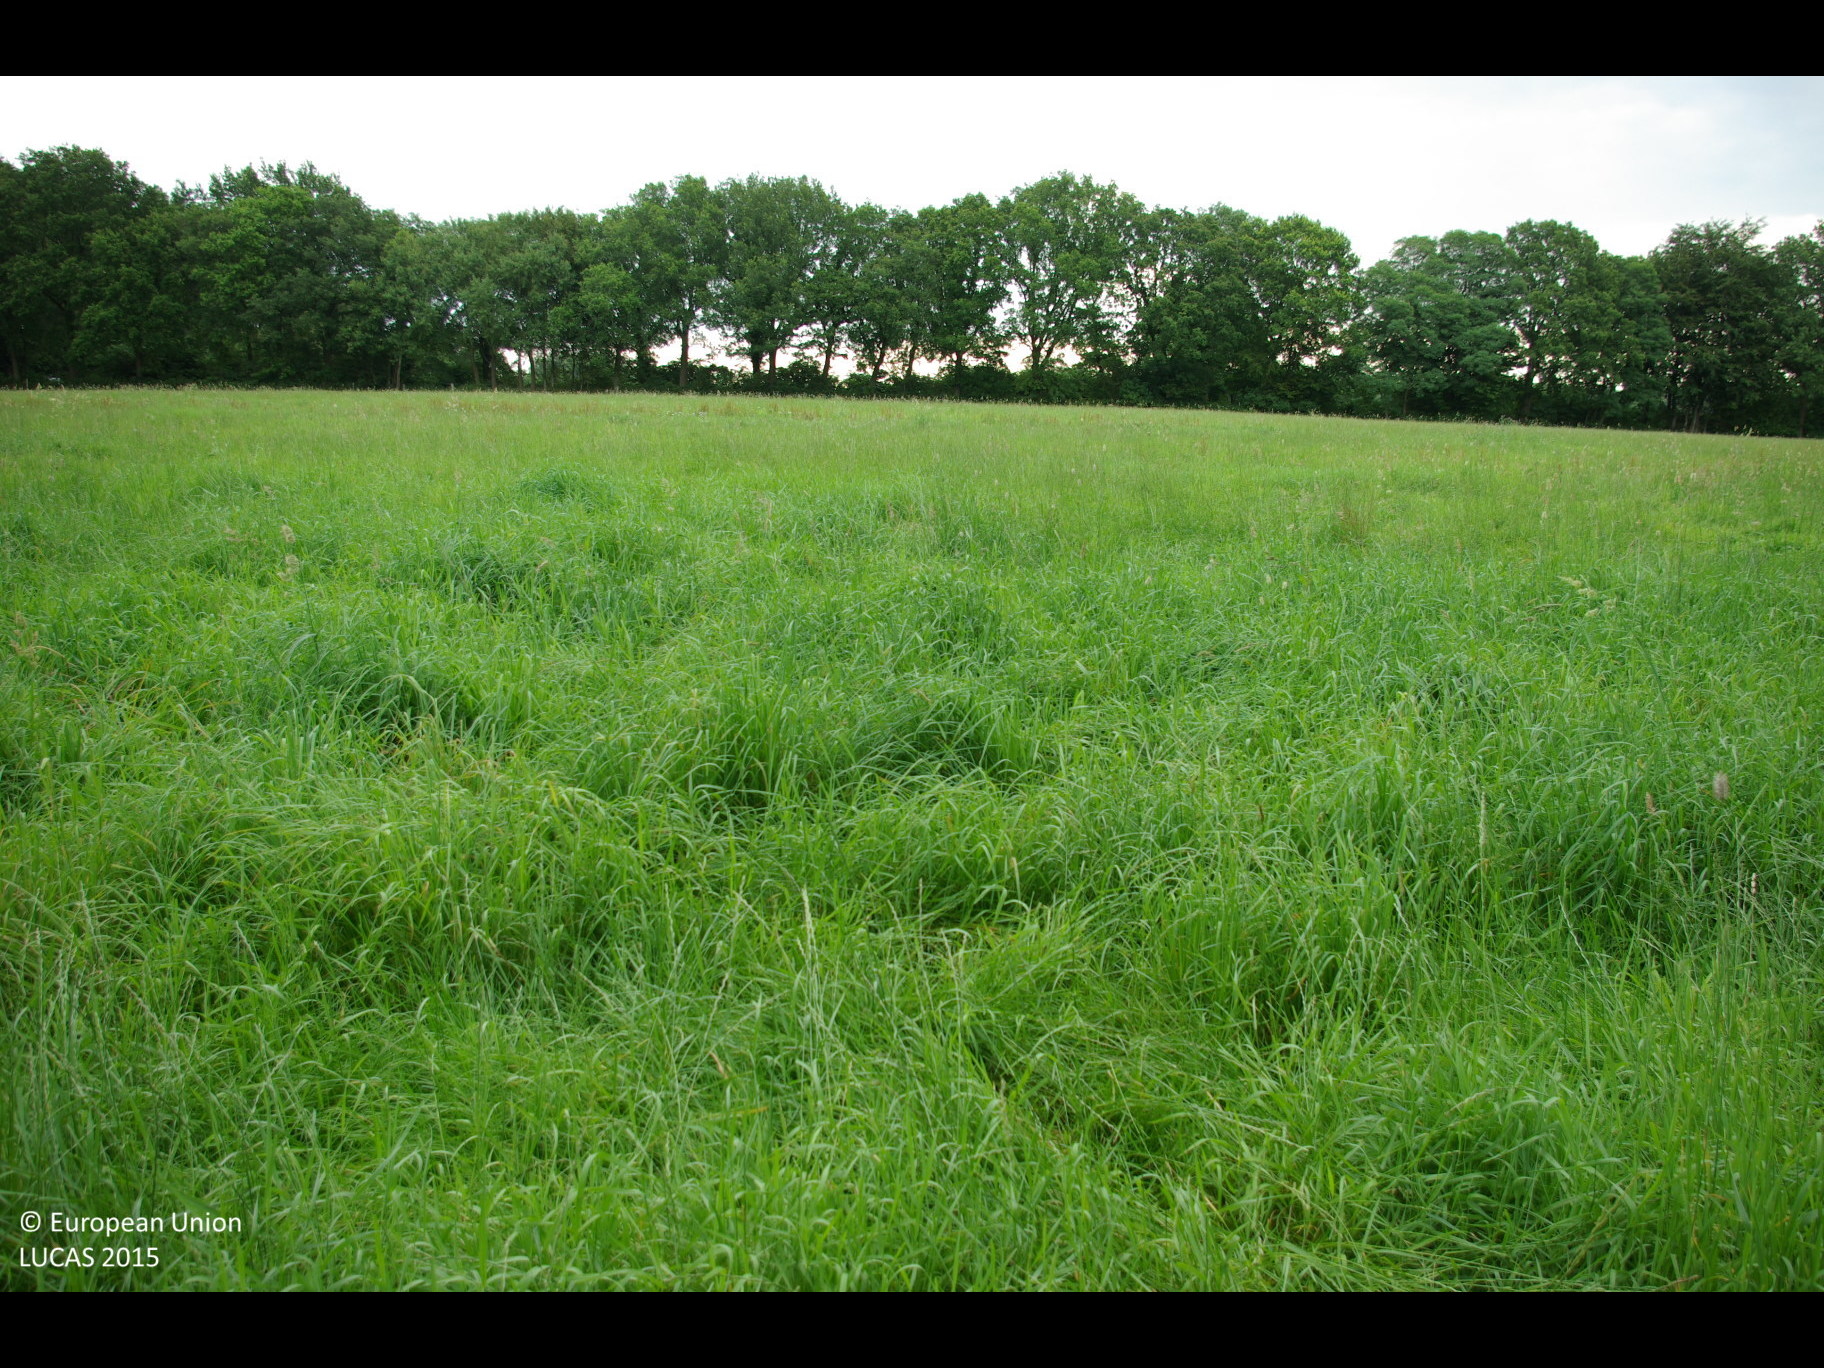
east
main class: Grassland
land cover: Grassland without tree/shrub cover
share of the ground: > 75 %
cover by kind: herbaceous plants 100 %
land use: Agriculture (excluding fallow land and kitchen gardens)
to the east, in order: Grassland without tree/shrub cover; Fences; Broadleaved woodland; Grass margins; Tracks; Grass margins; Shruby margins; Broadleaved woodland; Barley; Grassland with sparse tree/shrub cover; Maize; Fences; Maize
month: August
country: DE
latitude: 54.1009
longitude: 9.3122
